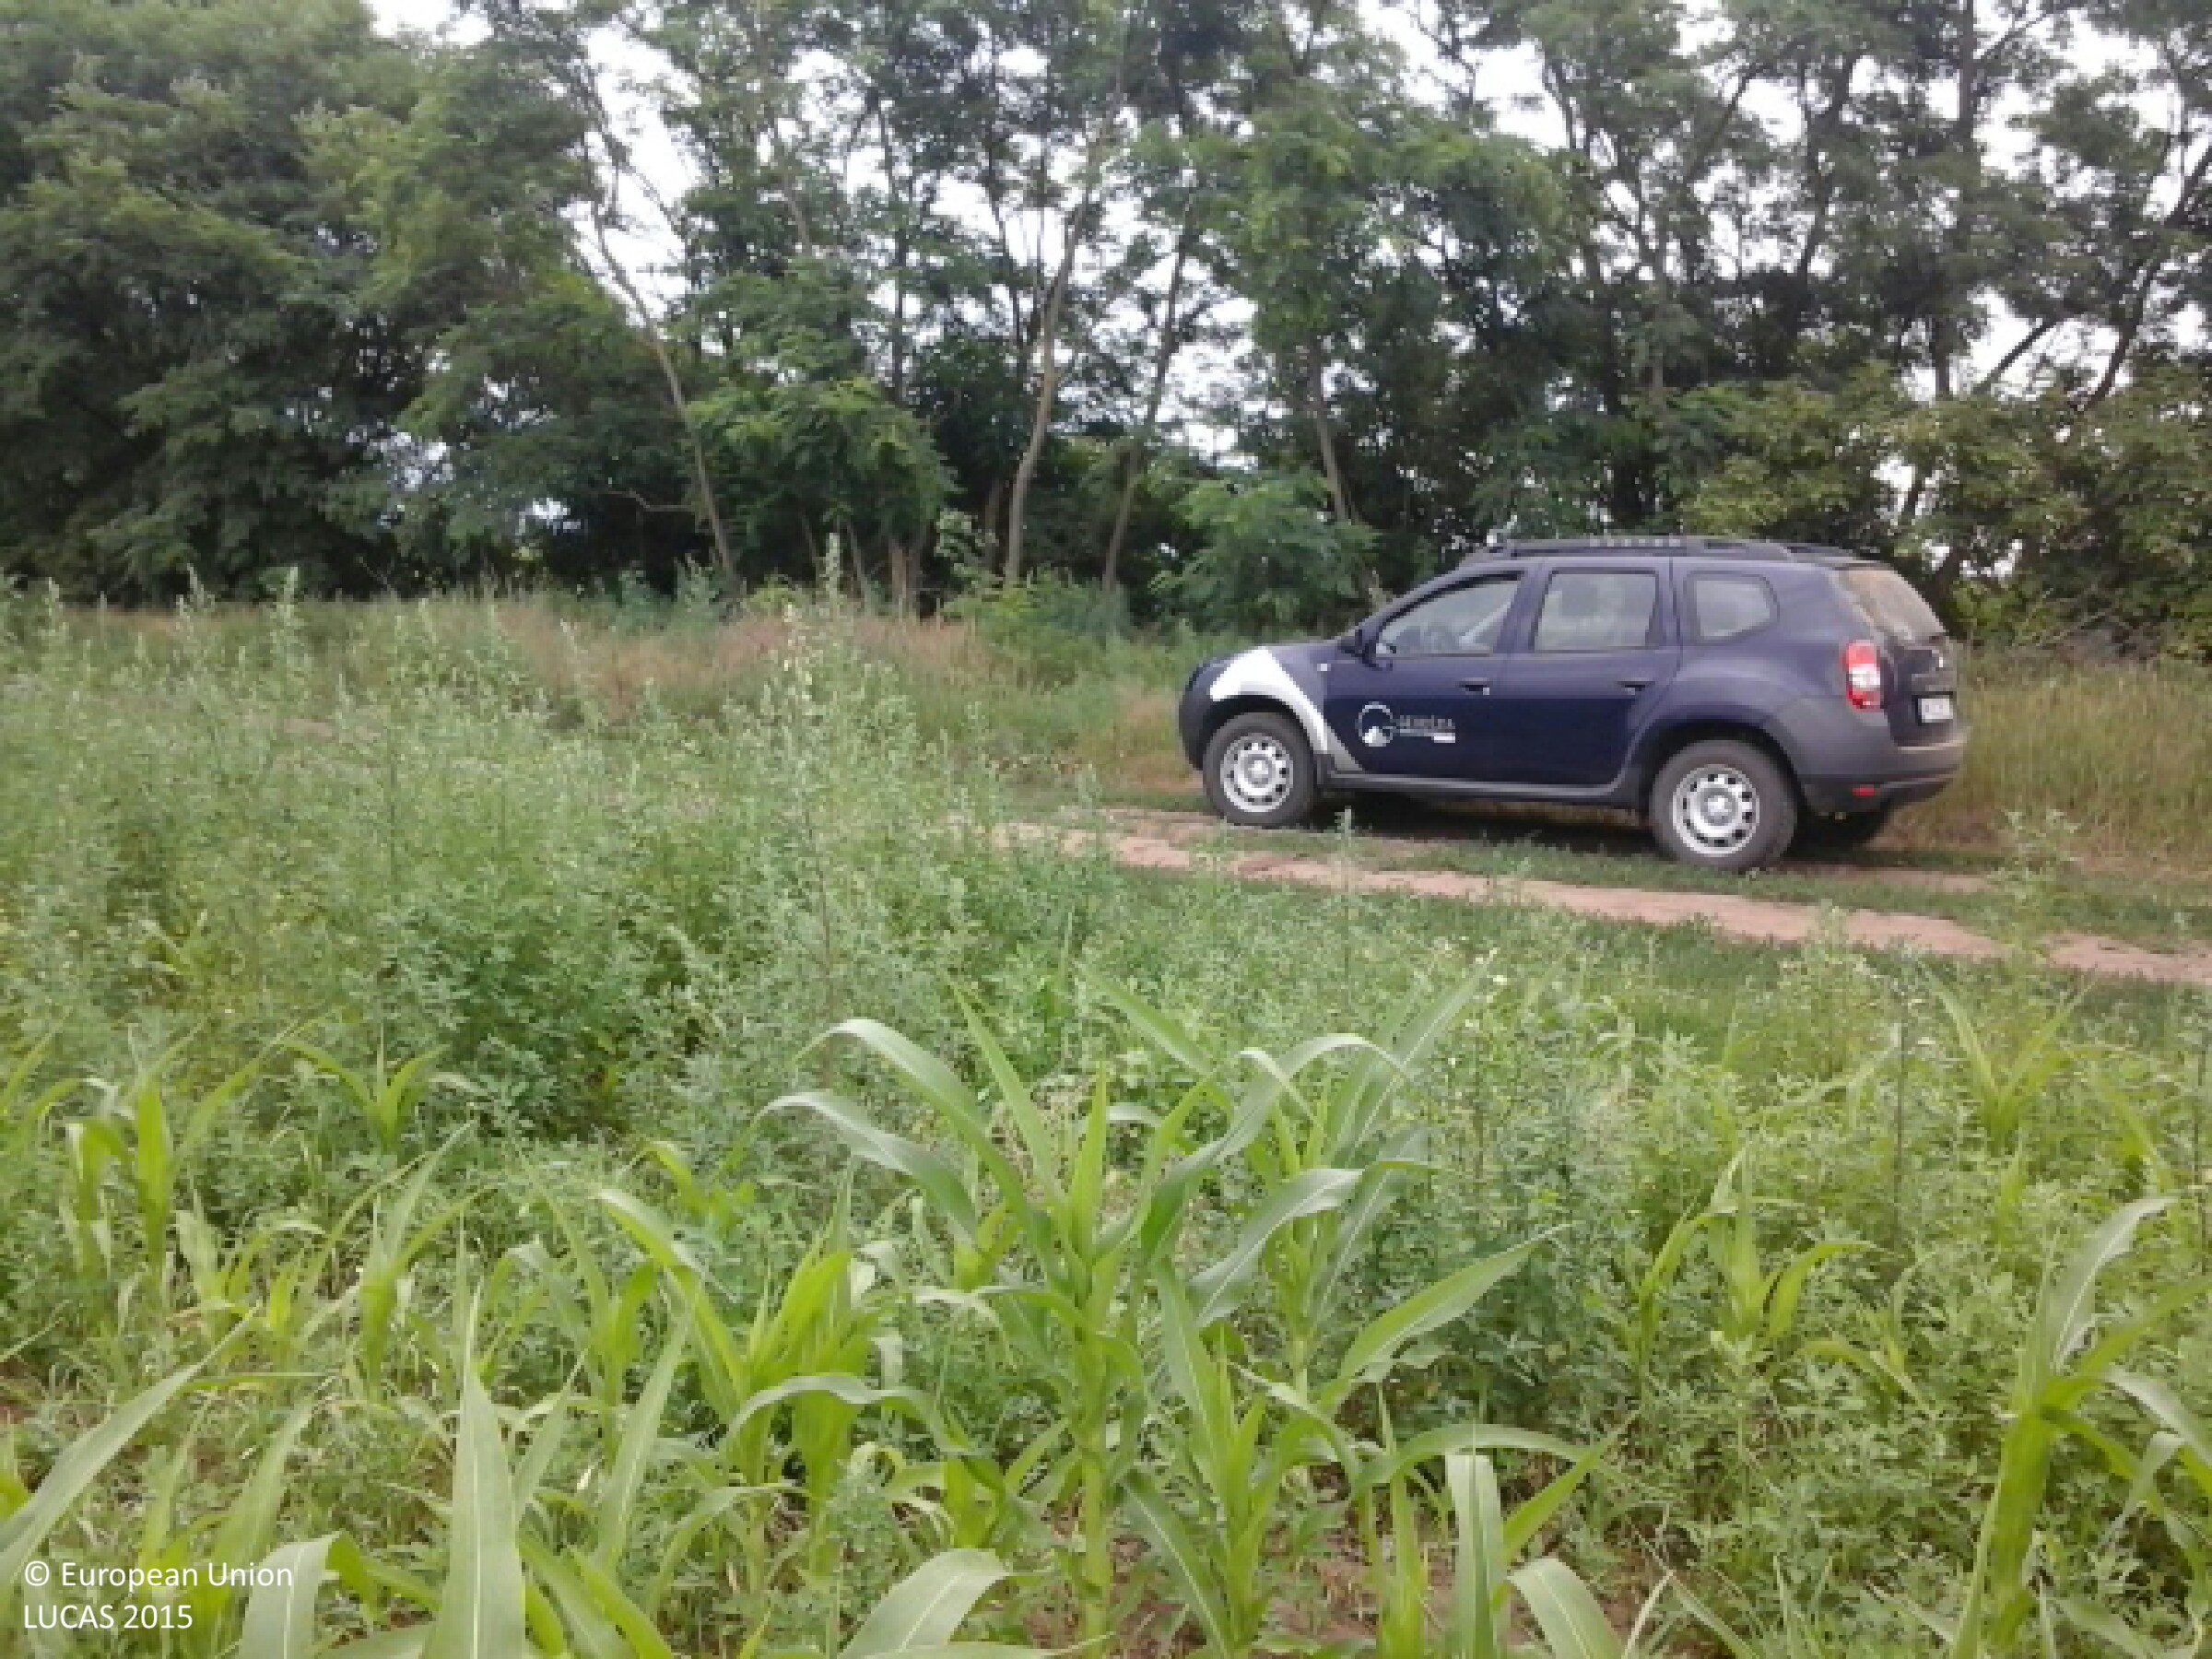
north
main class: Cropland
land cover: Maize
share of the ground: > 75 %
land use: Agriculture (excluding fallow land and kitchen gardens)
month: June
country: HU
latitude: 48.1249
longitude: 21.5330
